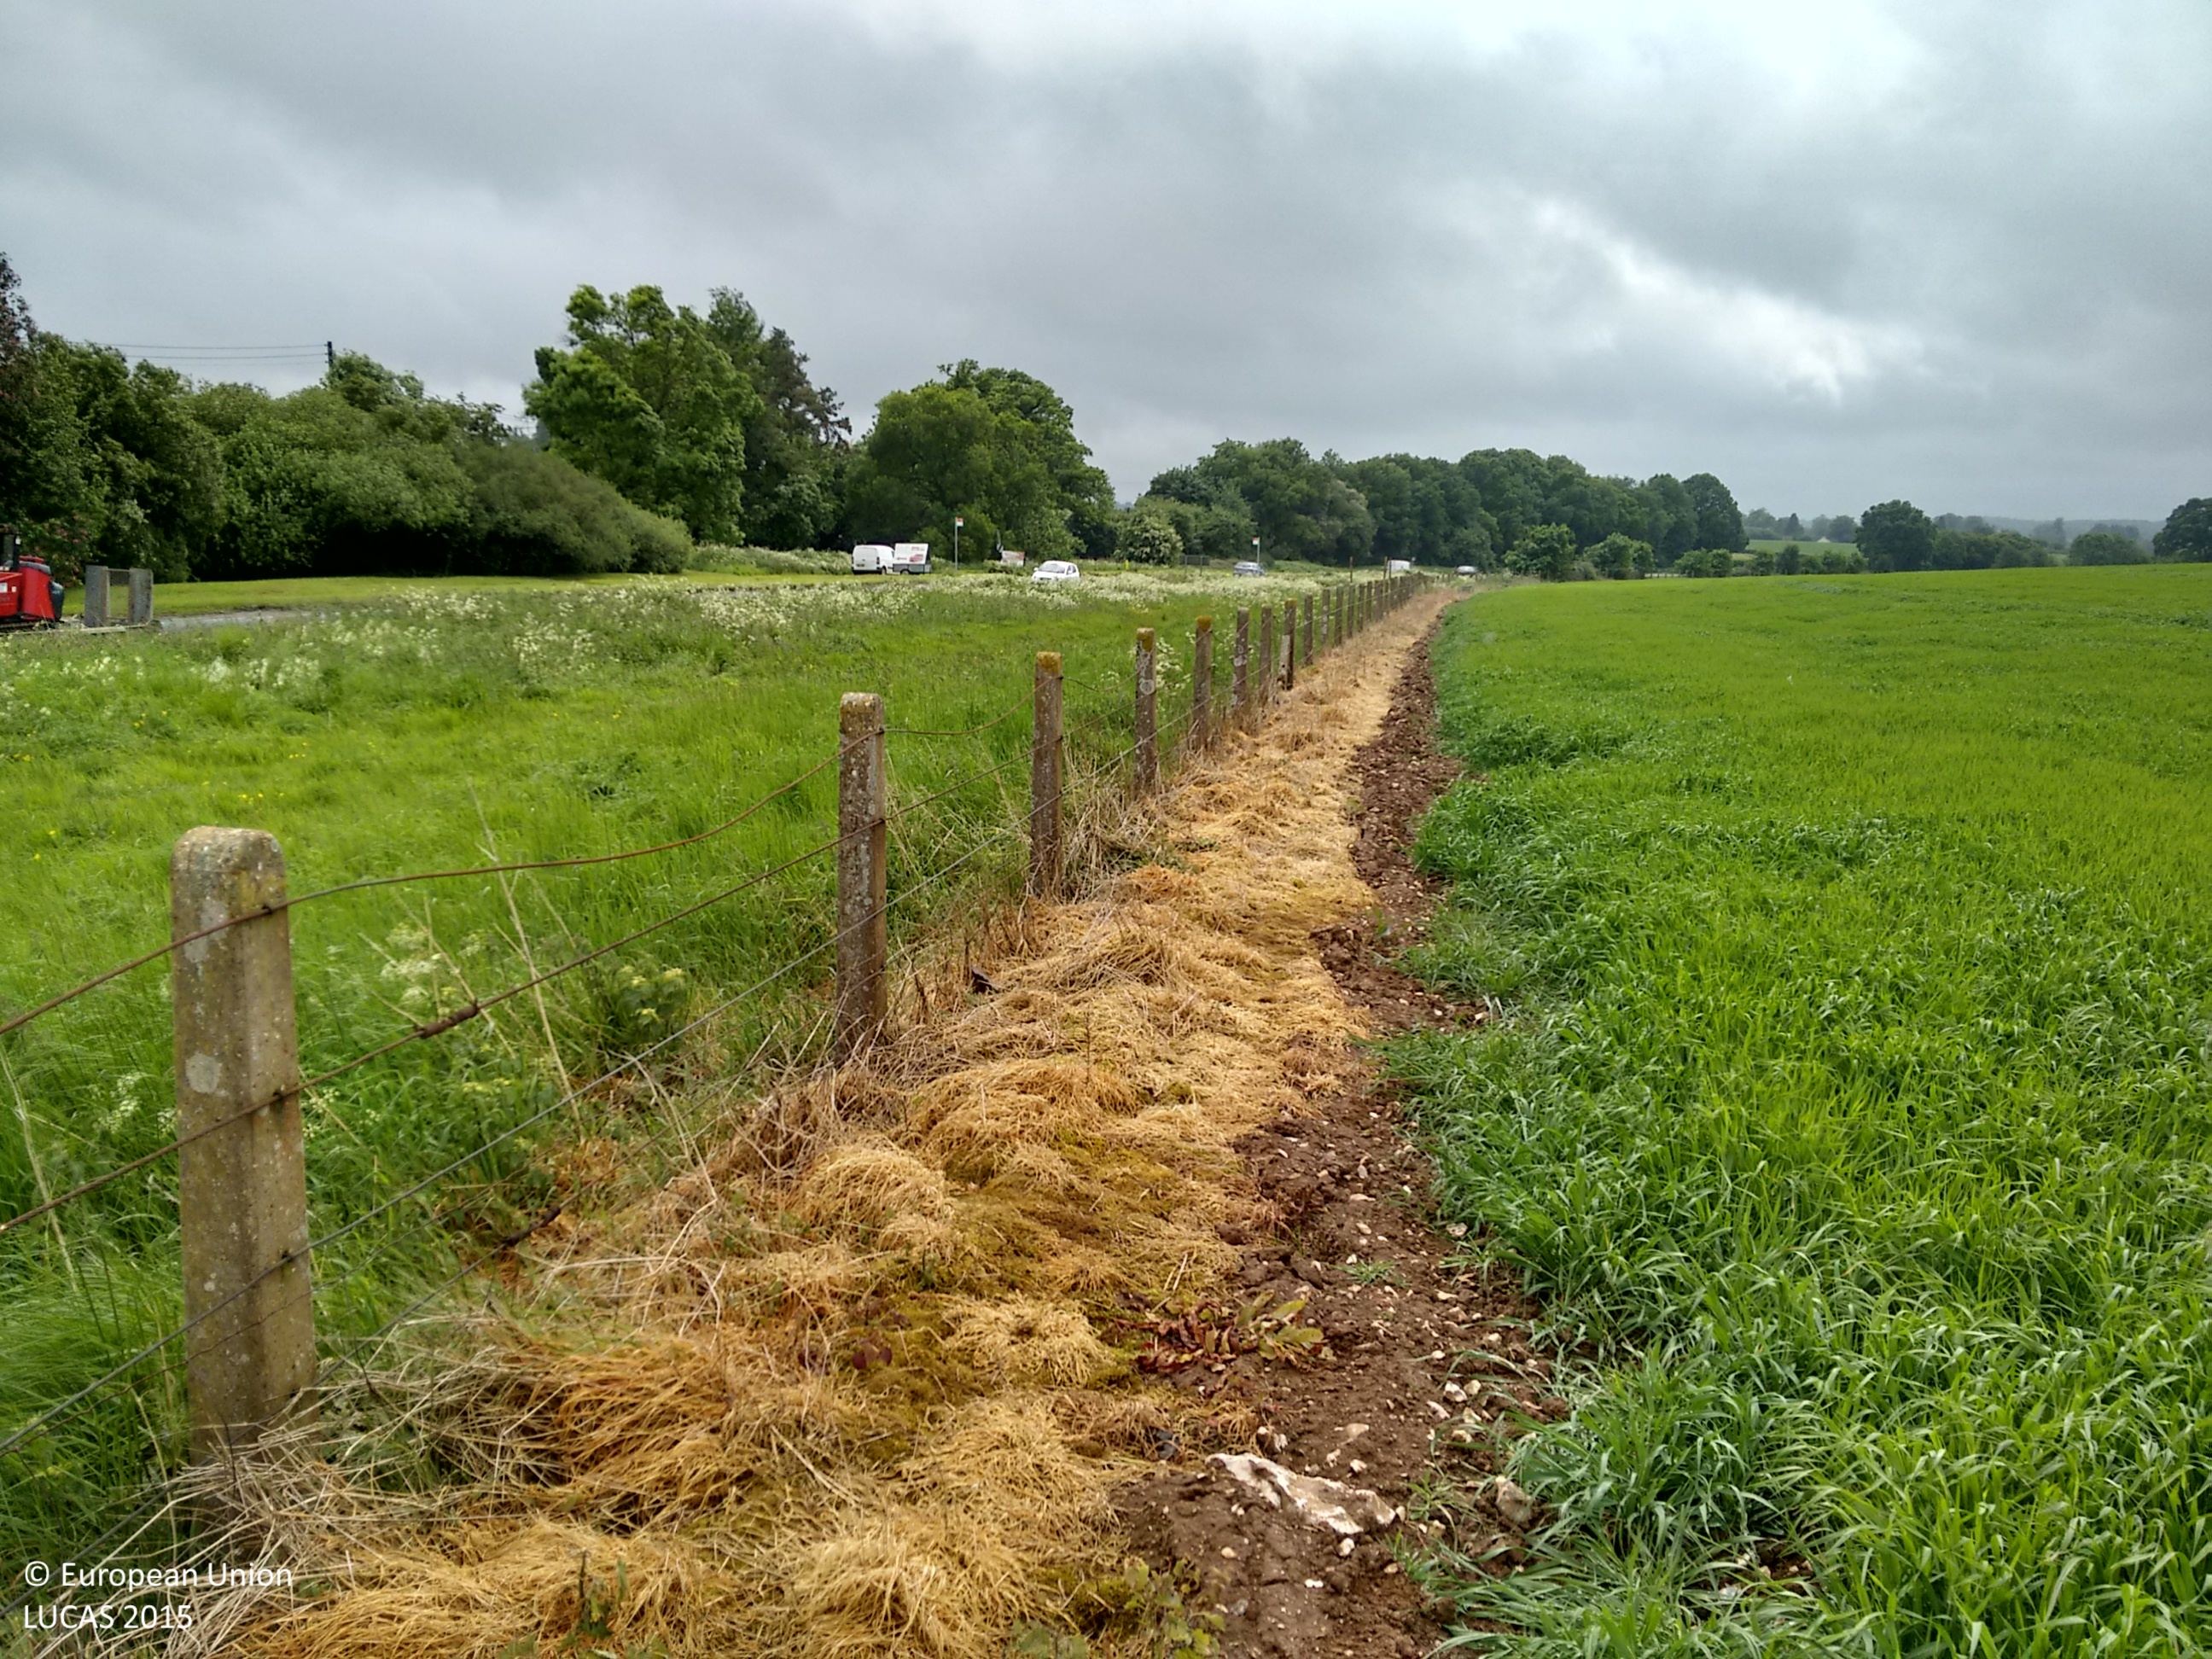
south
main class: Cropland
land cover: Barley
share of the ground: > 75 %
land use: Agriculture (excluding fallow land and kitchen gardens)
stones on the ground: 10 - 25 %
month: June
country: GB
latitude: 51.0943
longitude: -1.0830
